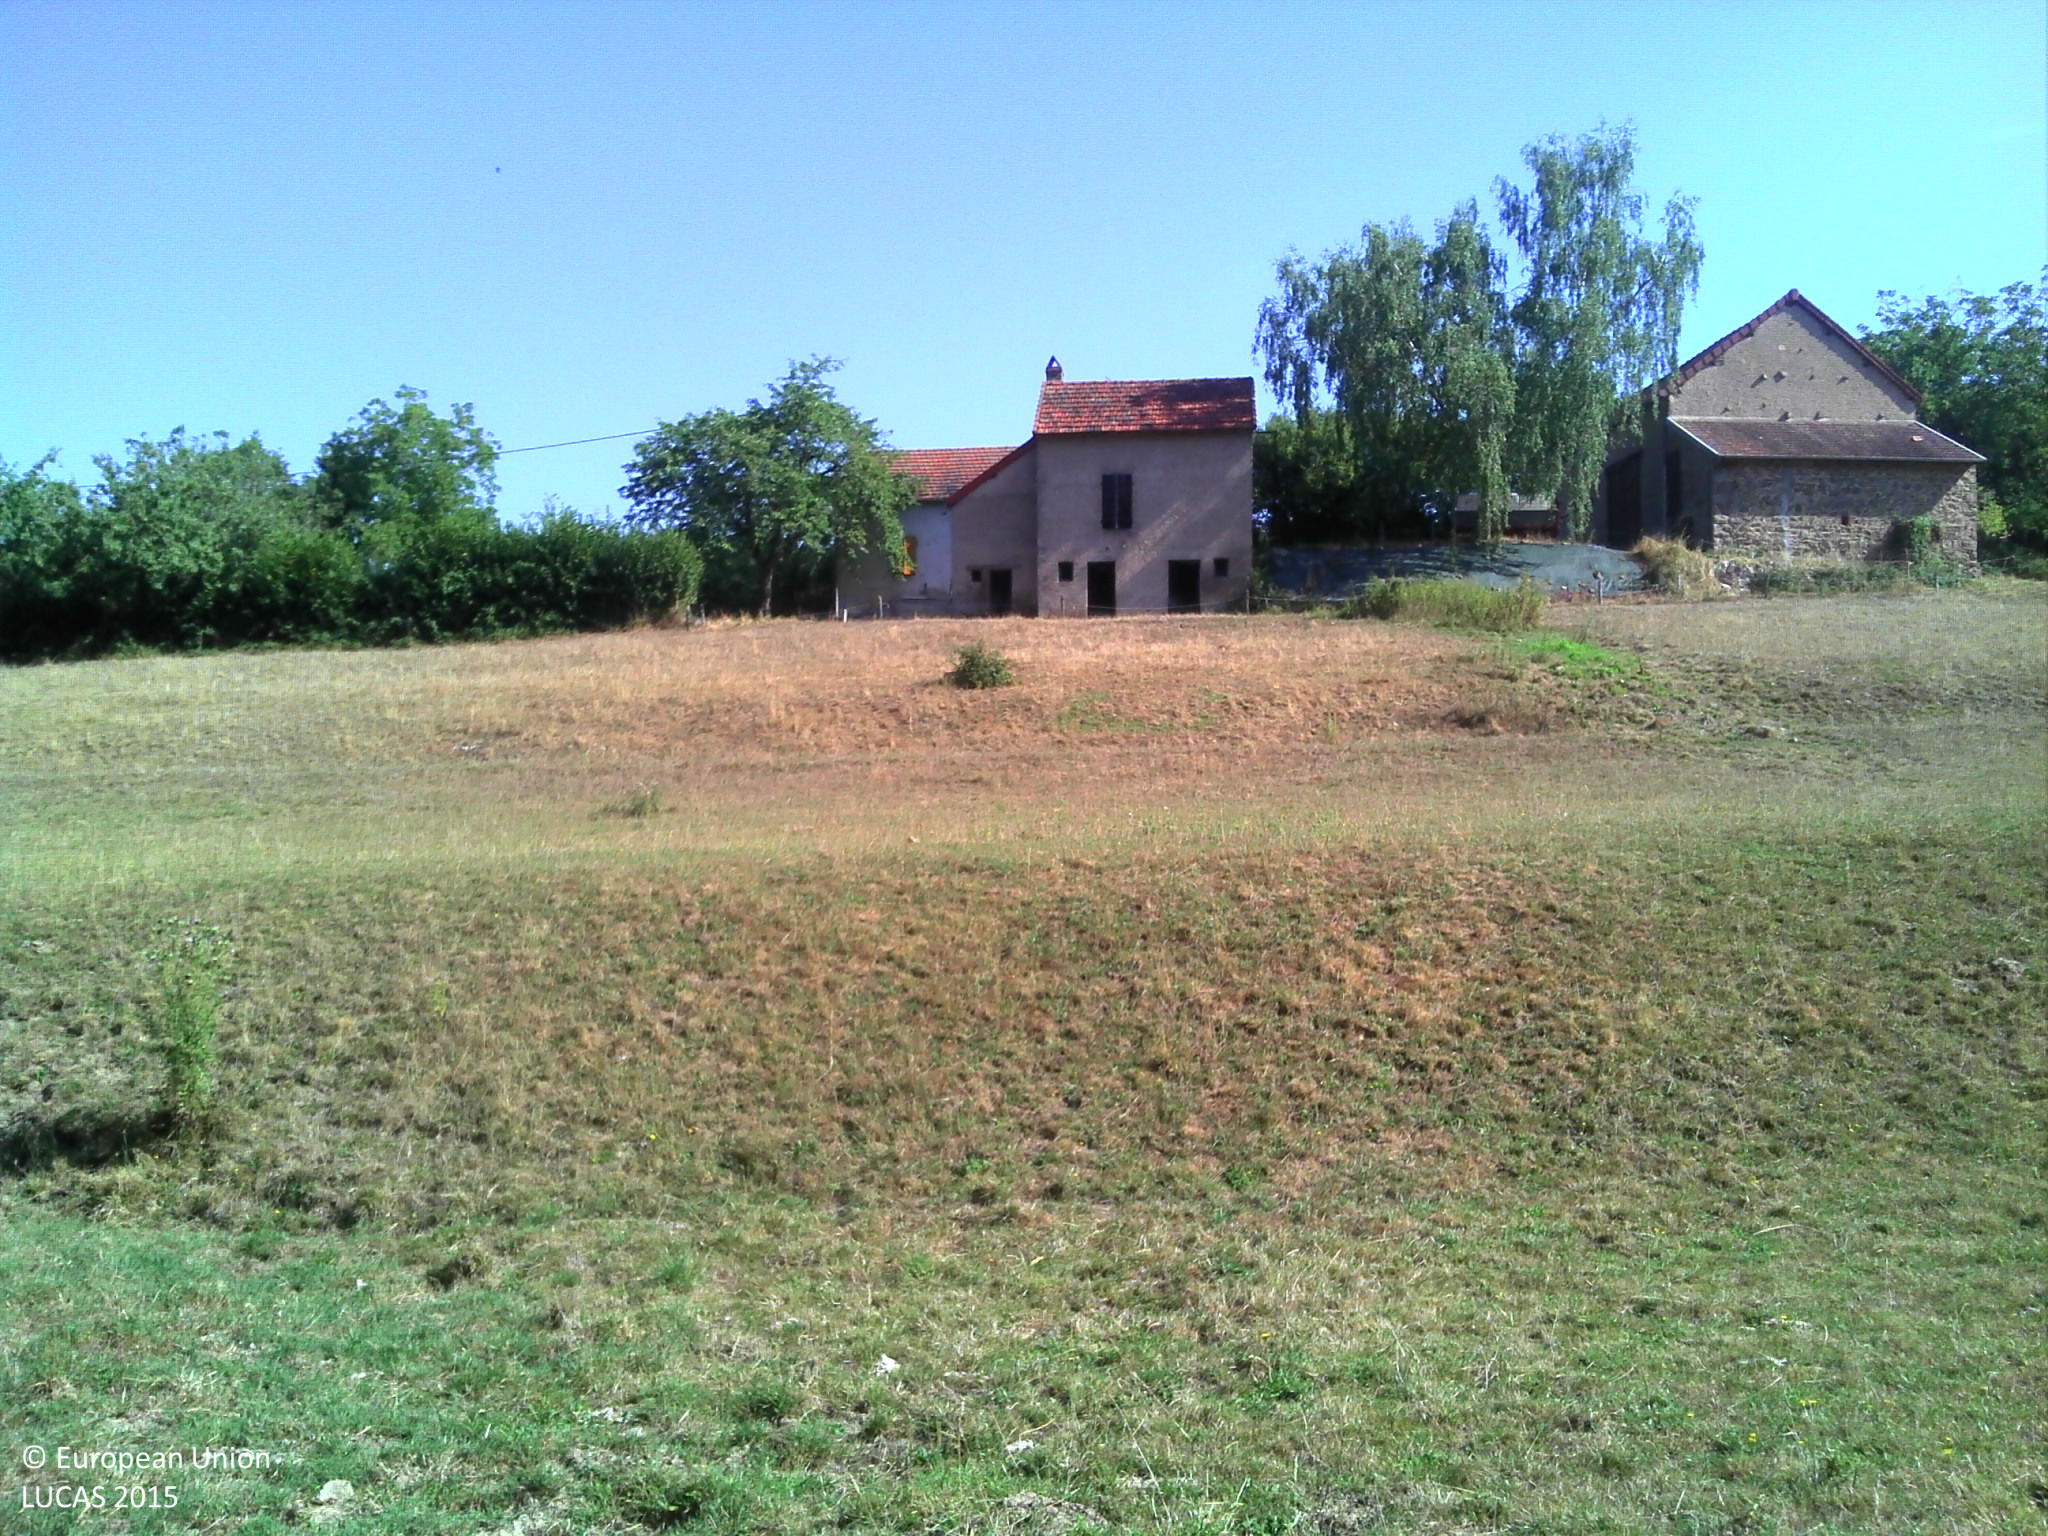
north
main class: Grassland
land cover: Grassland without tree/shrub cover
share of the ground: > 75 %
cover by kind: herbaceous plants 100 %
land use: Agriculture (excluding fallow land and kitchen gardens)
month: August
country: FR
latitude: 46.8171
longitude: 4.3776
